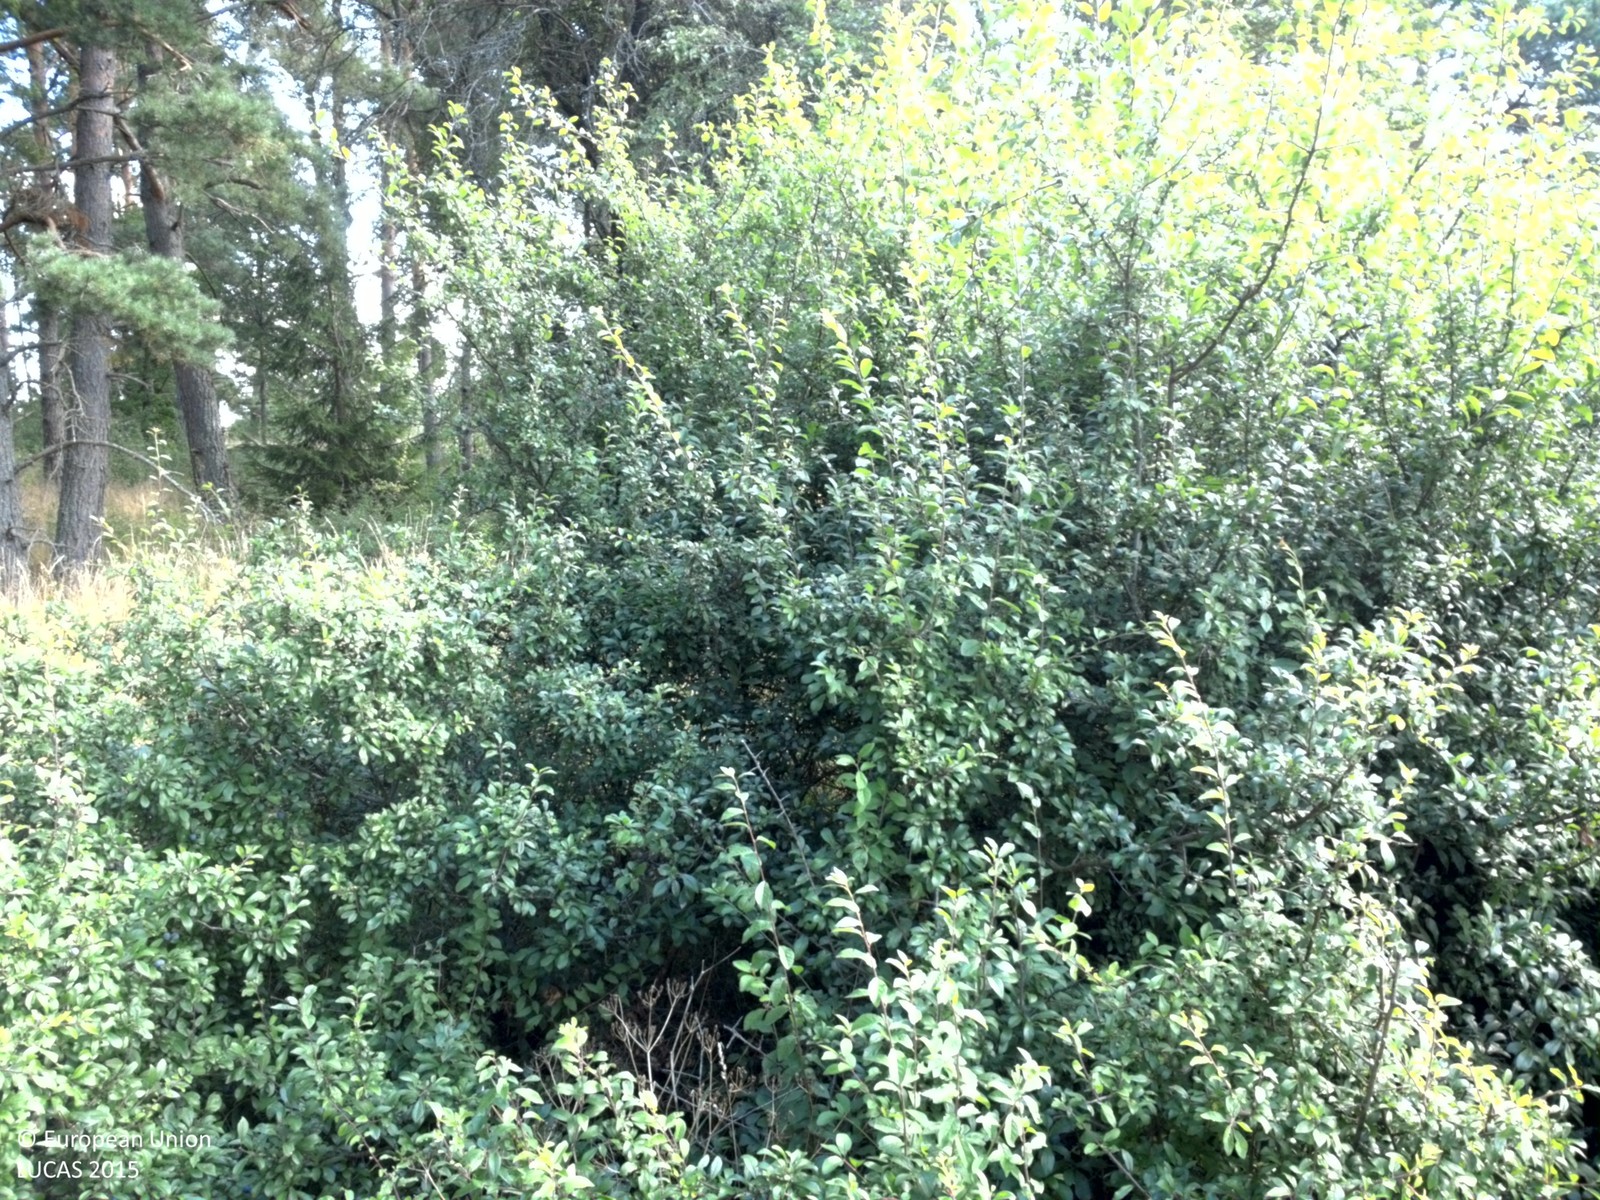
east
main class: Shrubland
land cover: Shrubland with sparse tree cover
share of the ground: > 75 %
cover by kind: shrubs 55 %, herbaceous plants 40 %, coniferous forest trees 5 %
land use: Semi-natural and natural areas not in use
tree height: > 5 m
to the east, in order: Shrubland with sparse tree cover; Pine dominated coniferous woodland; Shrubland with sparse tree cover; Fences; Electric lines; Grassland without tree/shrub cover; Broadleaved woodland; Grassland without tree/shrub cover; Tracks; Grassland without tree/shrub cover; Artificial constructions in urban areas
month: August
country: SE
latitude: 59.6202
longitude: 17.1378
